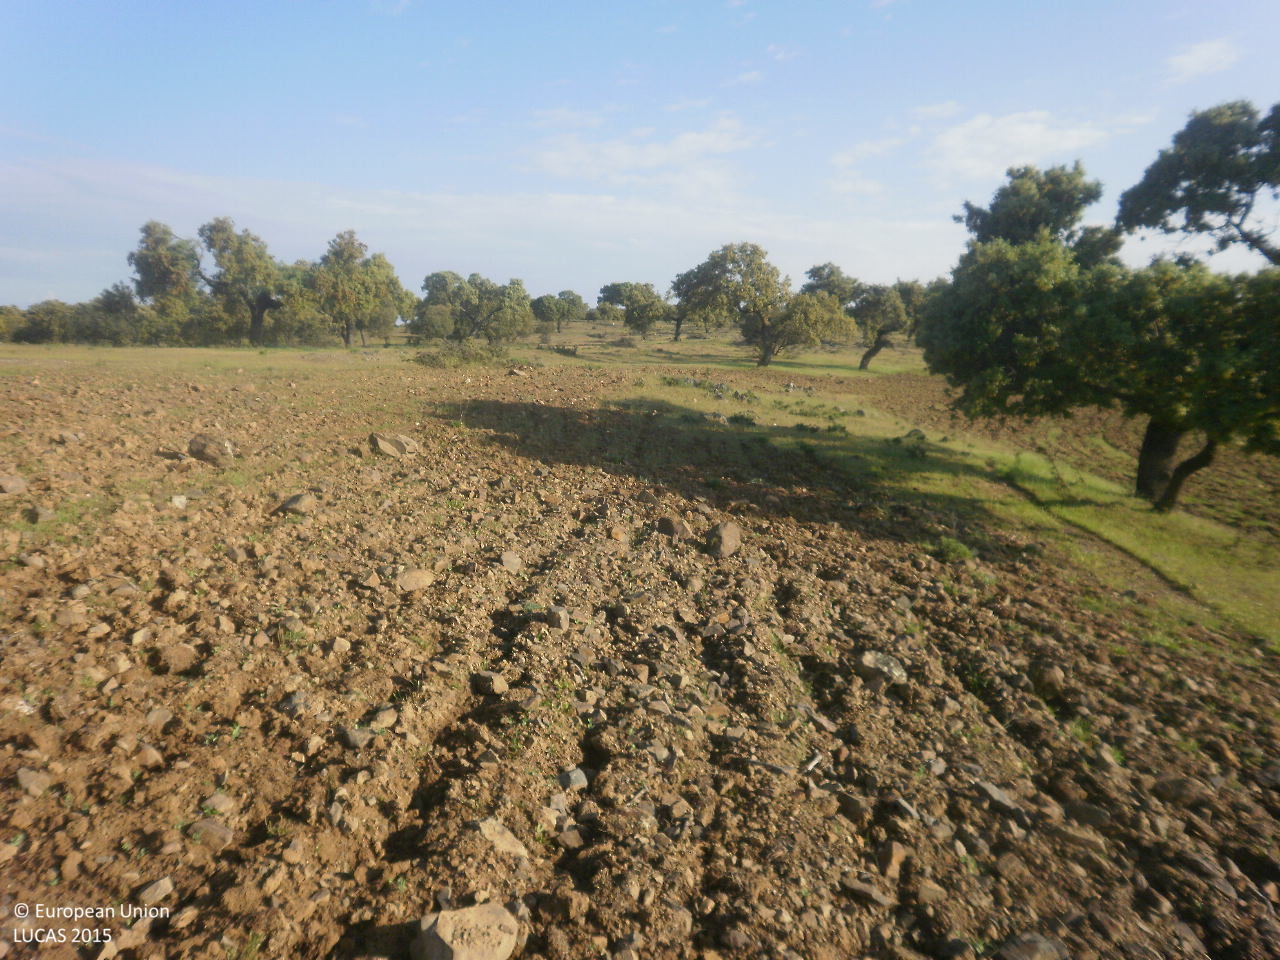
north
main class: Cropland
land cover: Dry pulses
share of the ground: < 10 %
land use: Agriculture (excluding fallow land and kitchen gardens)
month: April
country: ES
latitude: 38.7428
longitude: -5.2101
